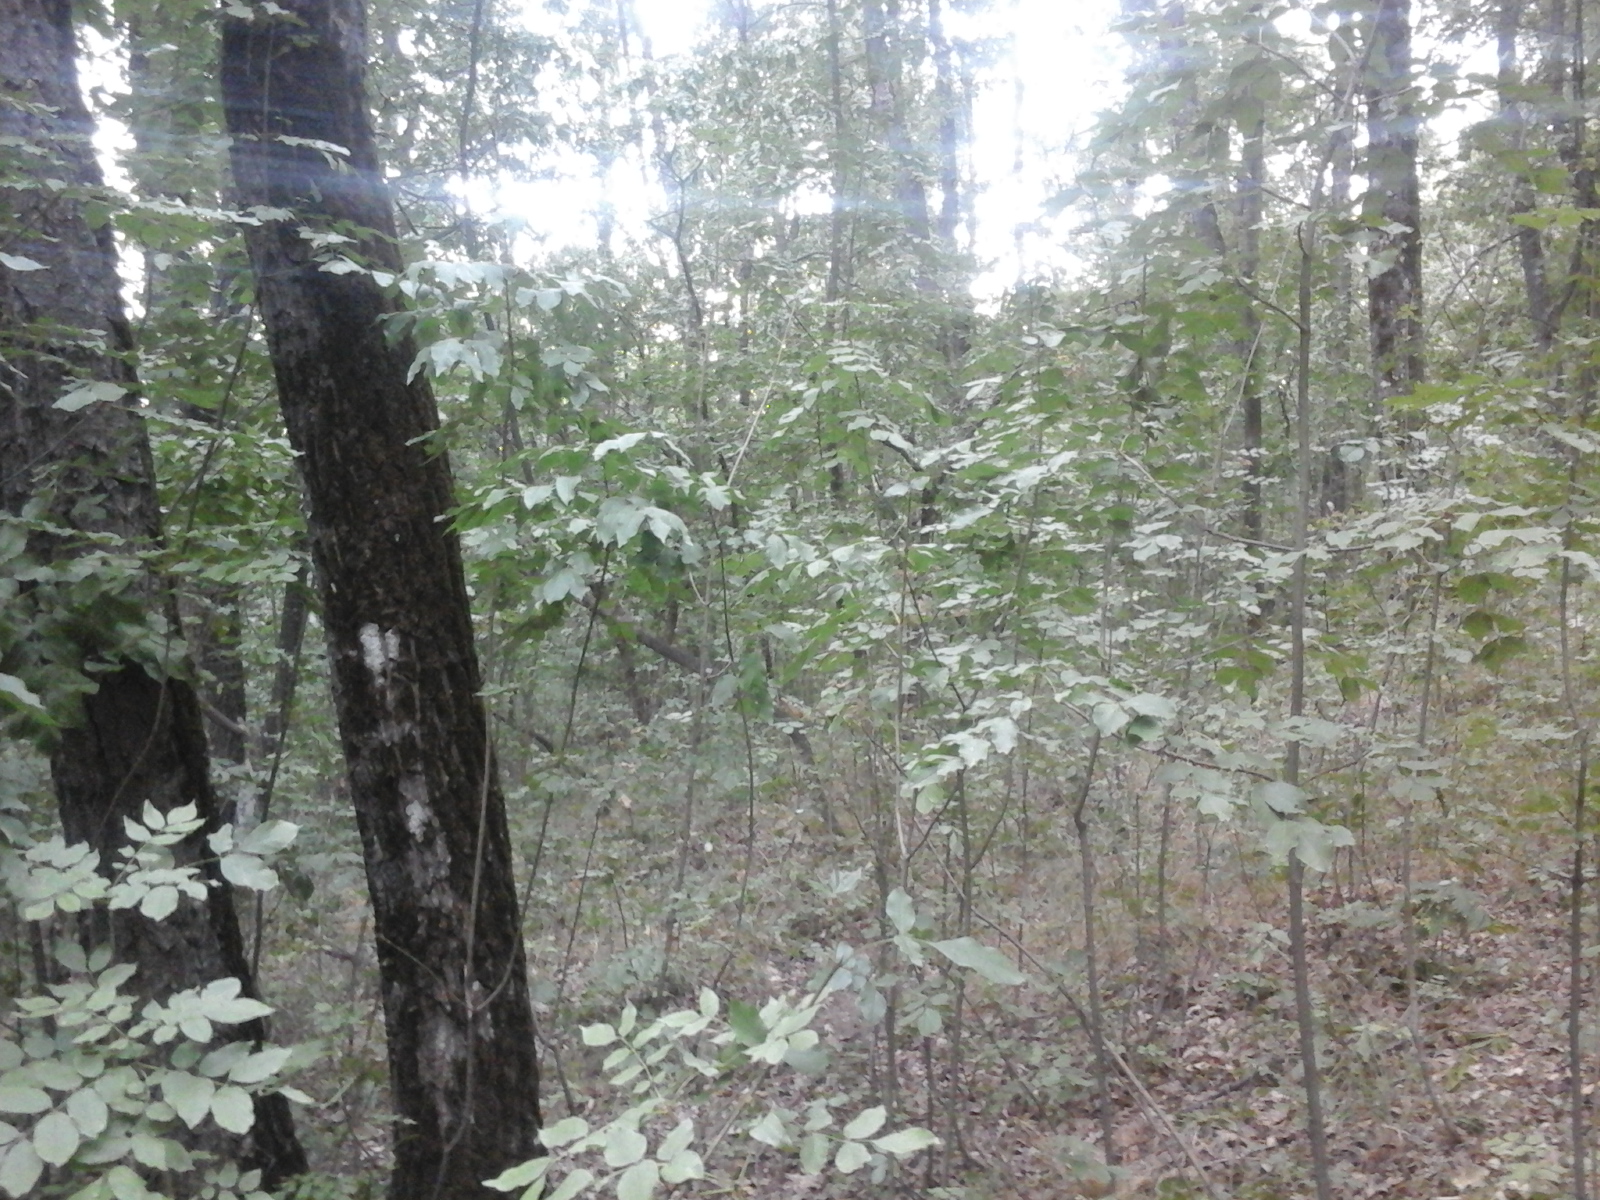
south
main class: Woodland
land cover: Broadleaved woodland
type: acidophilous oak and oak-birch forest
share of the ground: > 75 %
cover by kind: broadleaved forest trees 100 %
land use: Forestry
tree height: > 5 m
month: August
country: RO
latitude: 44.6160
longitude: 23.3469
